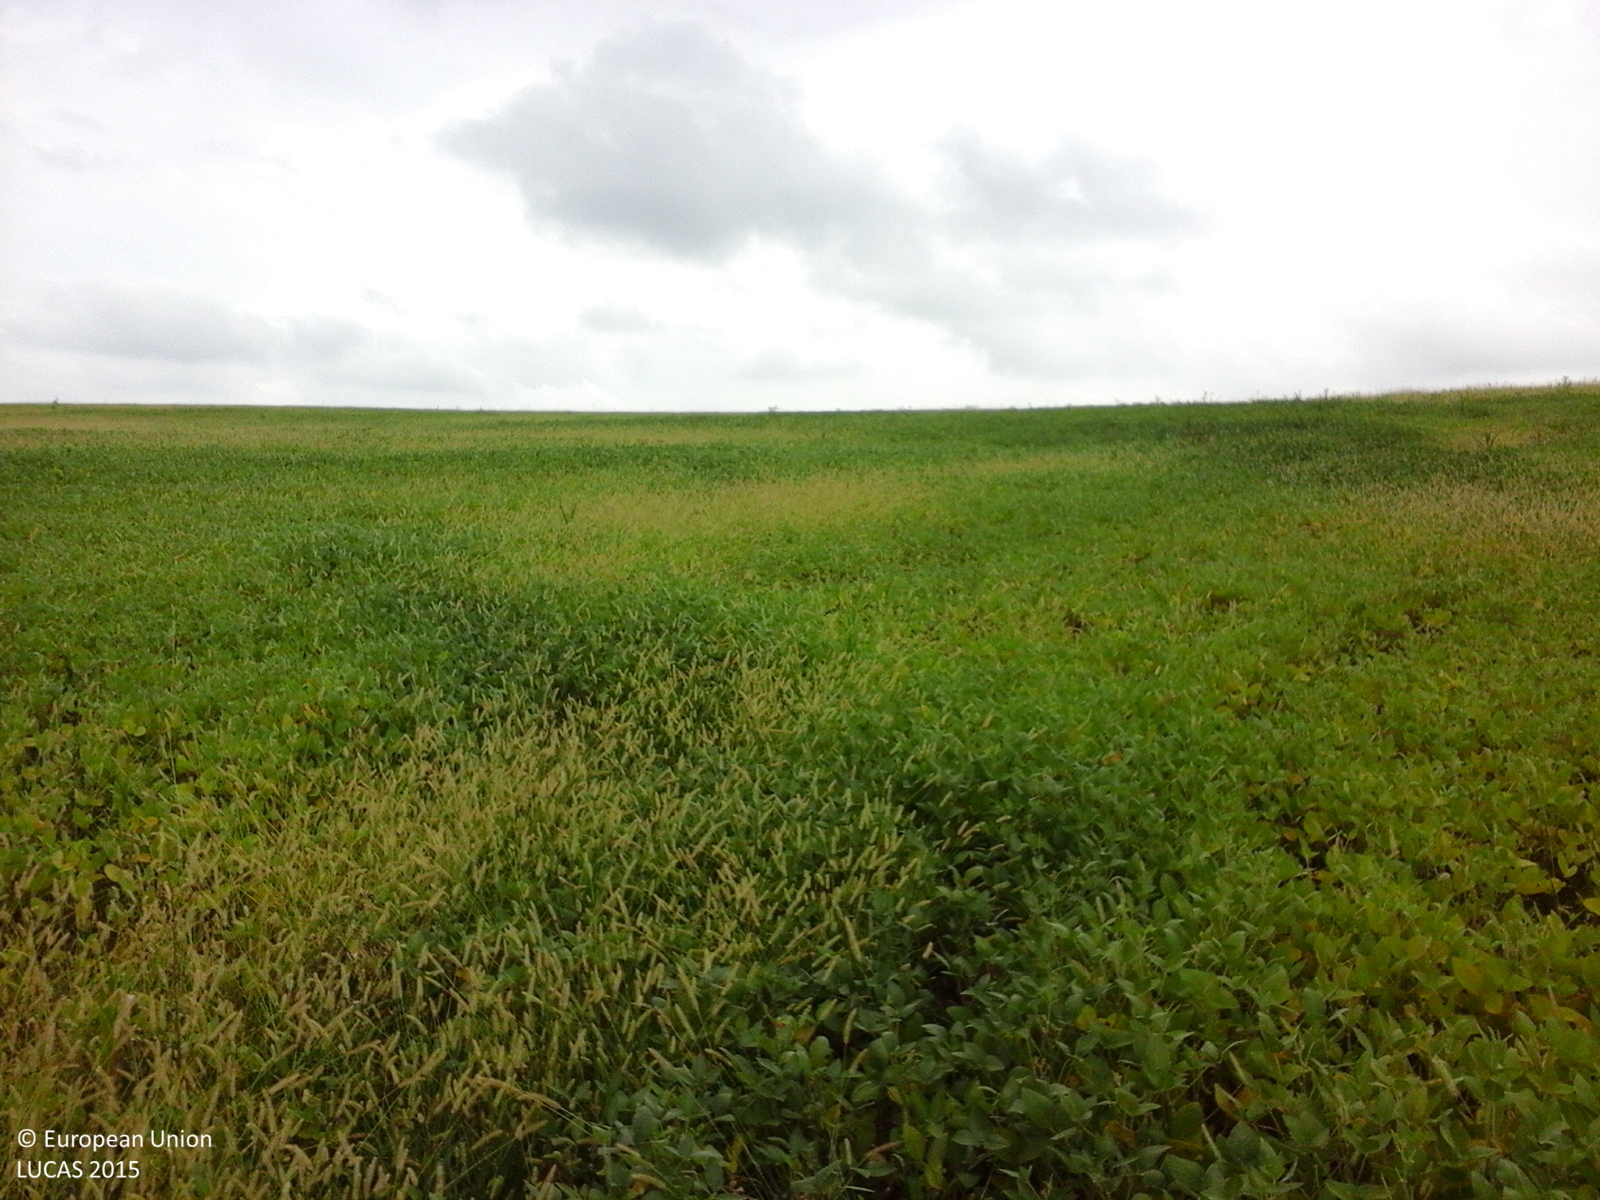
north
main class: Cropland
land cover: Soya
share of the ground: > 75 %
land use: Agriculture (excluding fallow land and kitchen gardens)
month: August
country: RO
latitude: 45.5725
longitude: 21.7608
